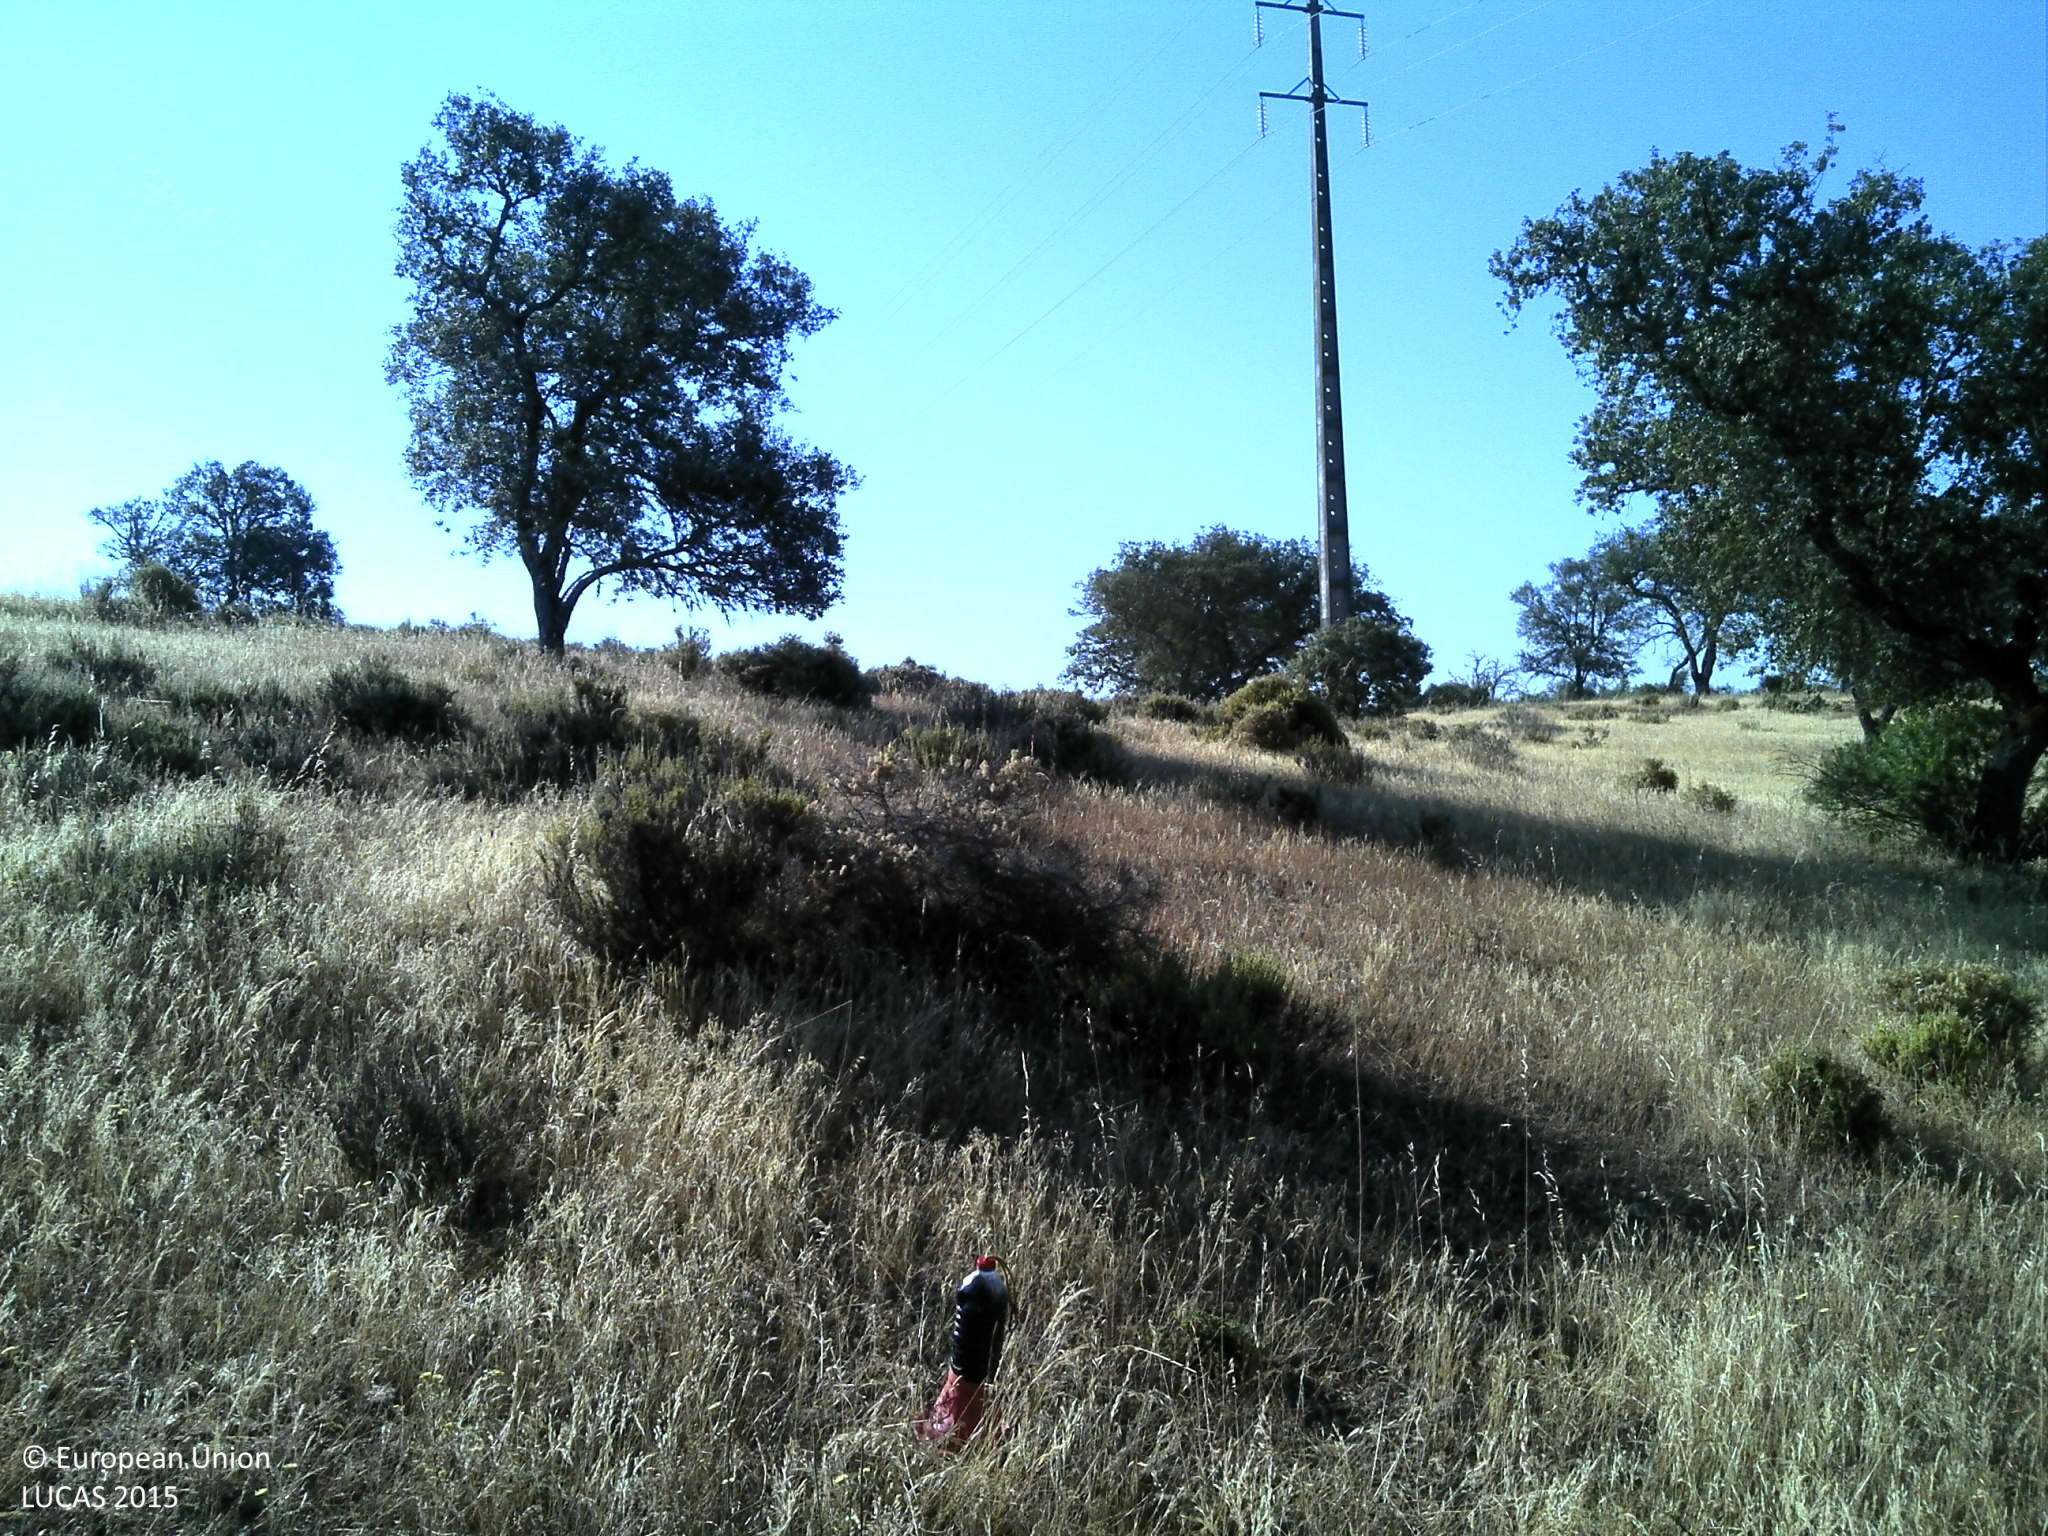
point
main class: Woodland
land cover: Broadleaved woodland
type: broadleaved evergreen forest
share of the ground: 10 - 25 %
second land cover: Grassland without tree/shrub cover
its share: 25 - 50 %
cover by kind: herbaceous plants 50 %, unconsolidated bare surface 35 %, broadleaved forest trees 15 %
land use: Forestry
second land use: Agriculture (excluding fallow land and kitchen gardens)
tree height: > 5 m
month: June
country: PT
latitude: 38.2934
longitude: -7.6943
